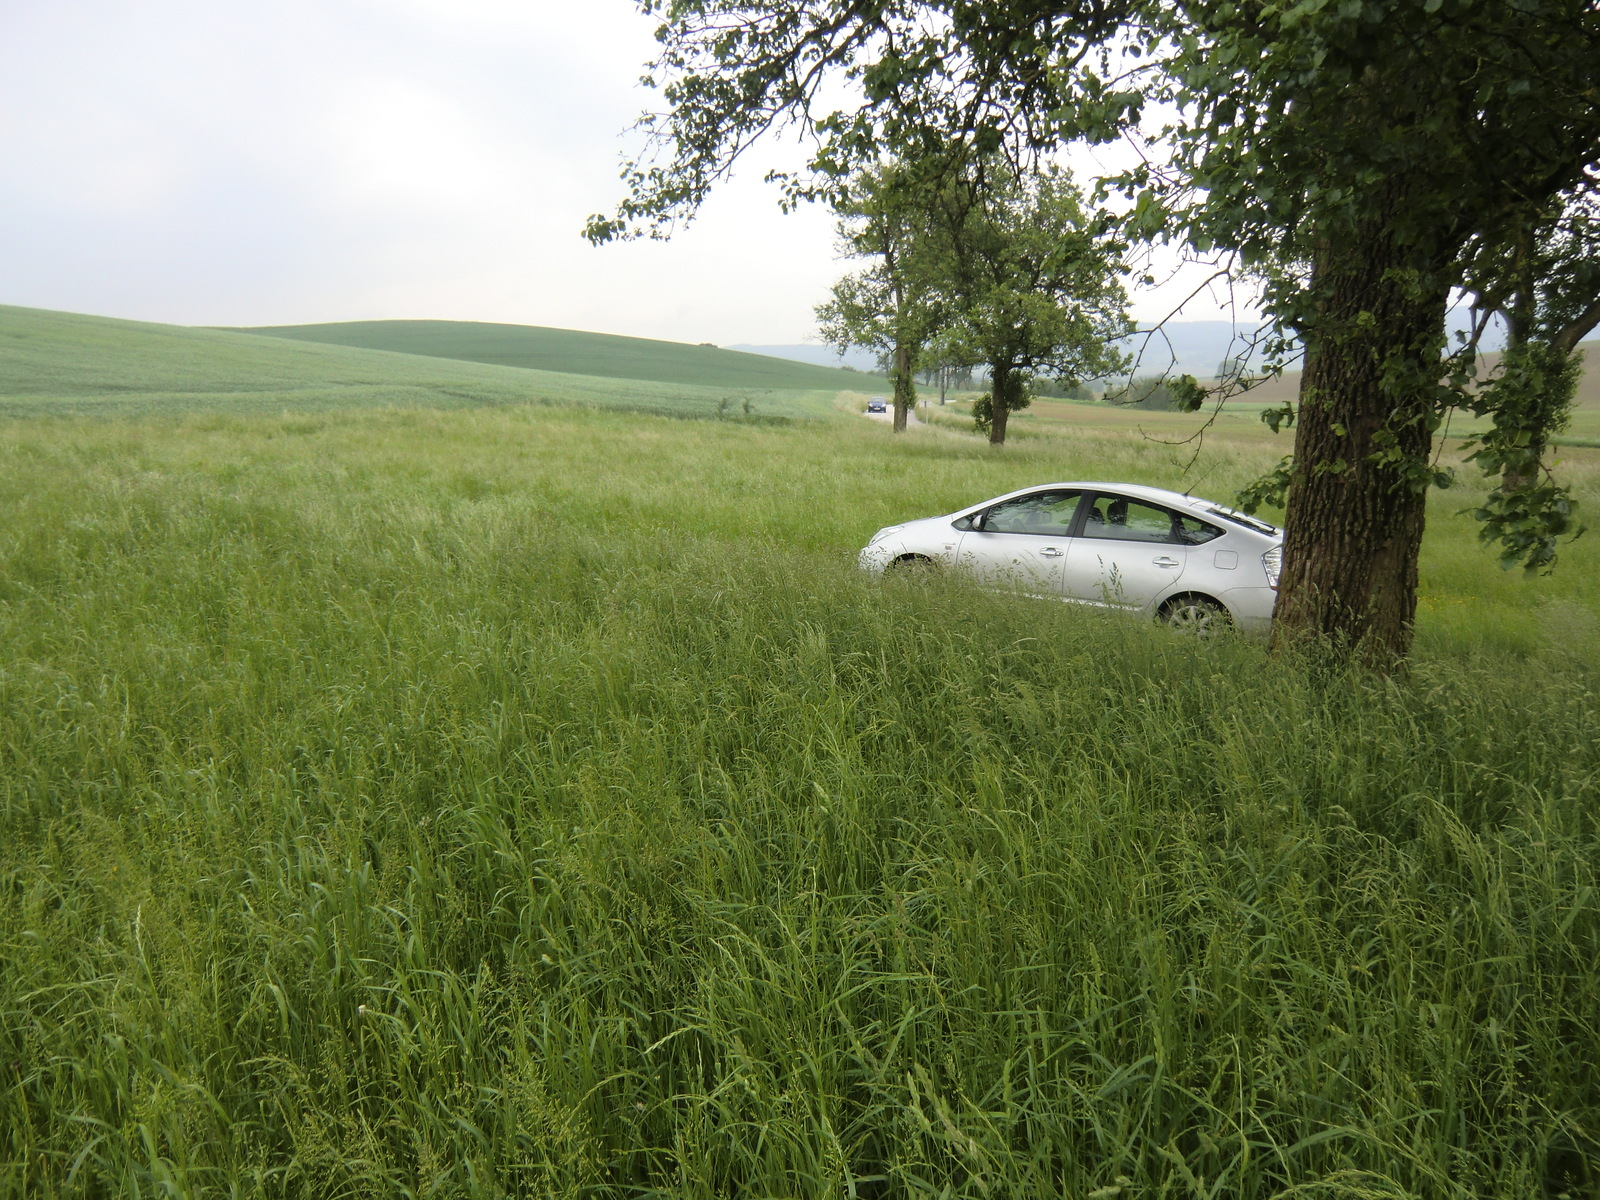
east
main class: Cropland
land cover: Pear fruit
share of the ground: 50 - 75 %
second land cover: Grassland without tree/shrub cover
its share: > 75 %
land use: Agriculture (excluding fallow land and kitchen gardens)
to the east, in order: Pear fruit; Grassland without tree/shrub cover; Tracks; Grassland without tree/shrub cover; Common wheat
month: May
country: AT
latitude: 48.1265
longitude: 15.4164
